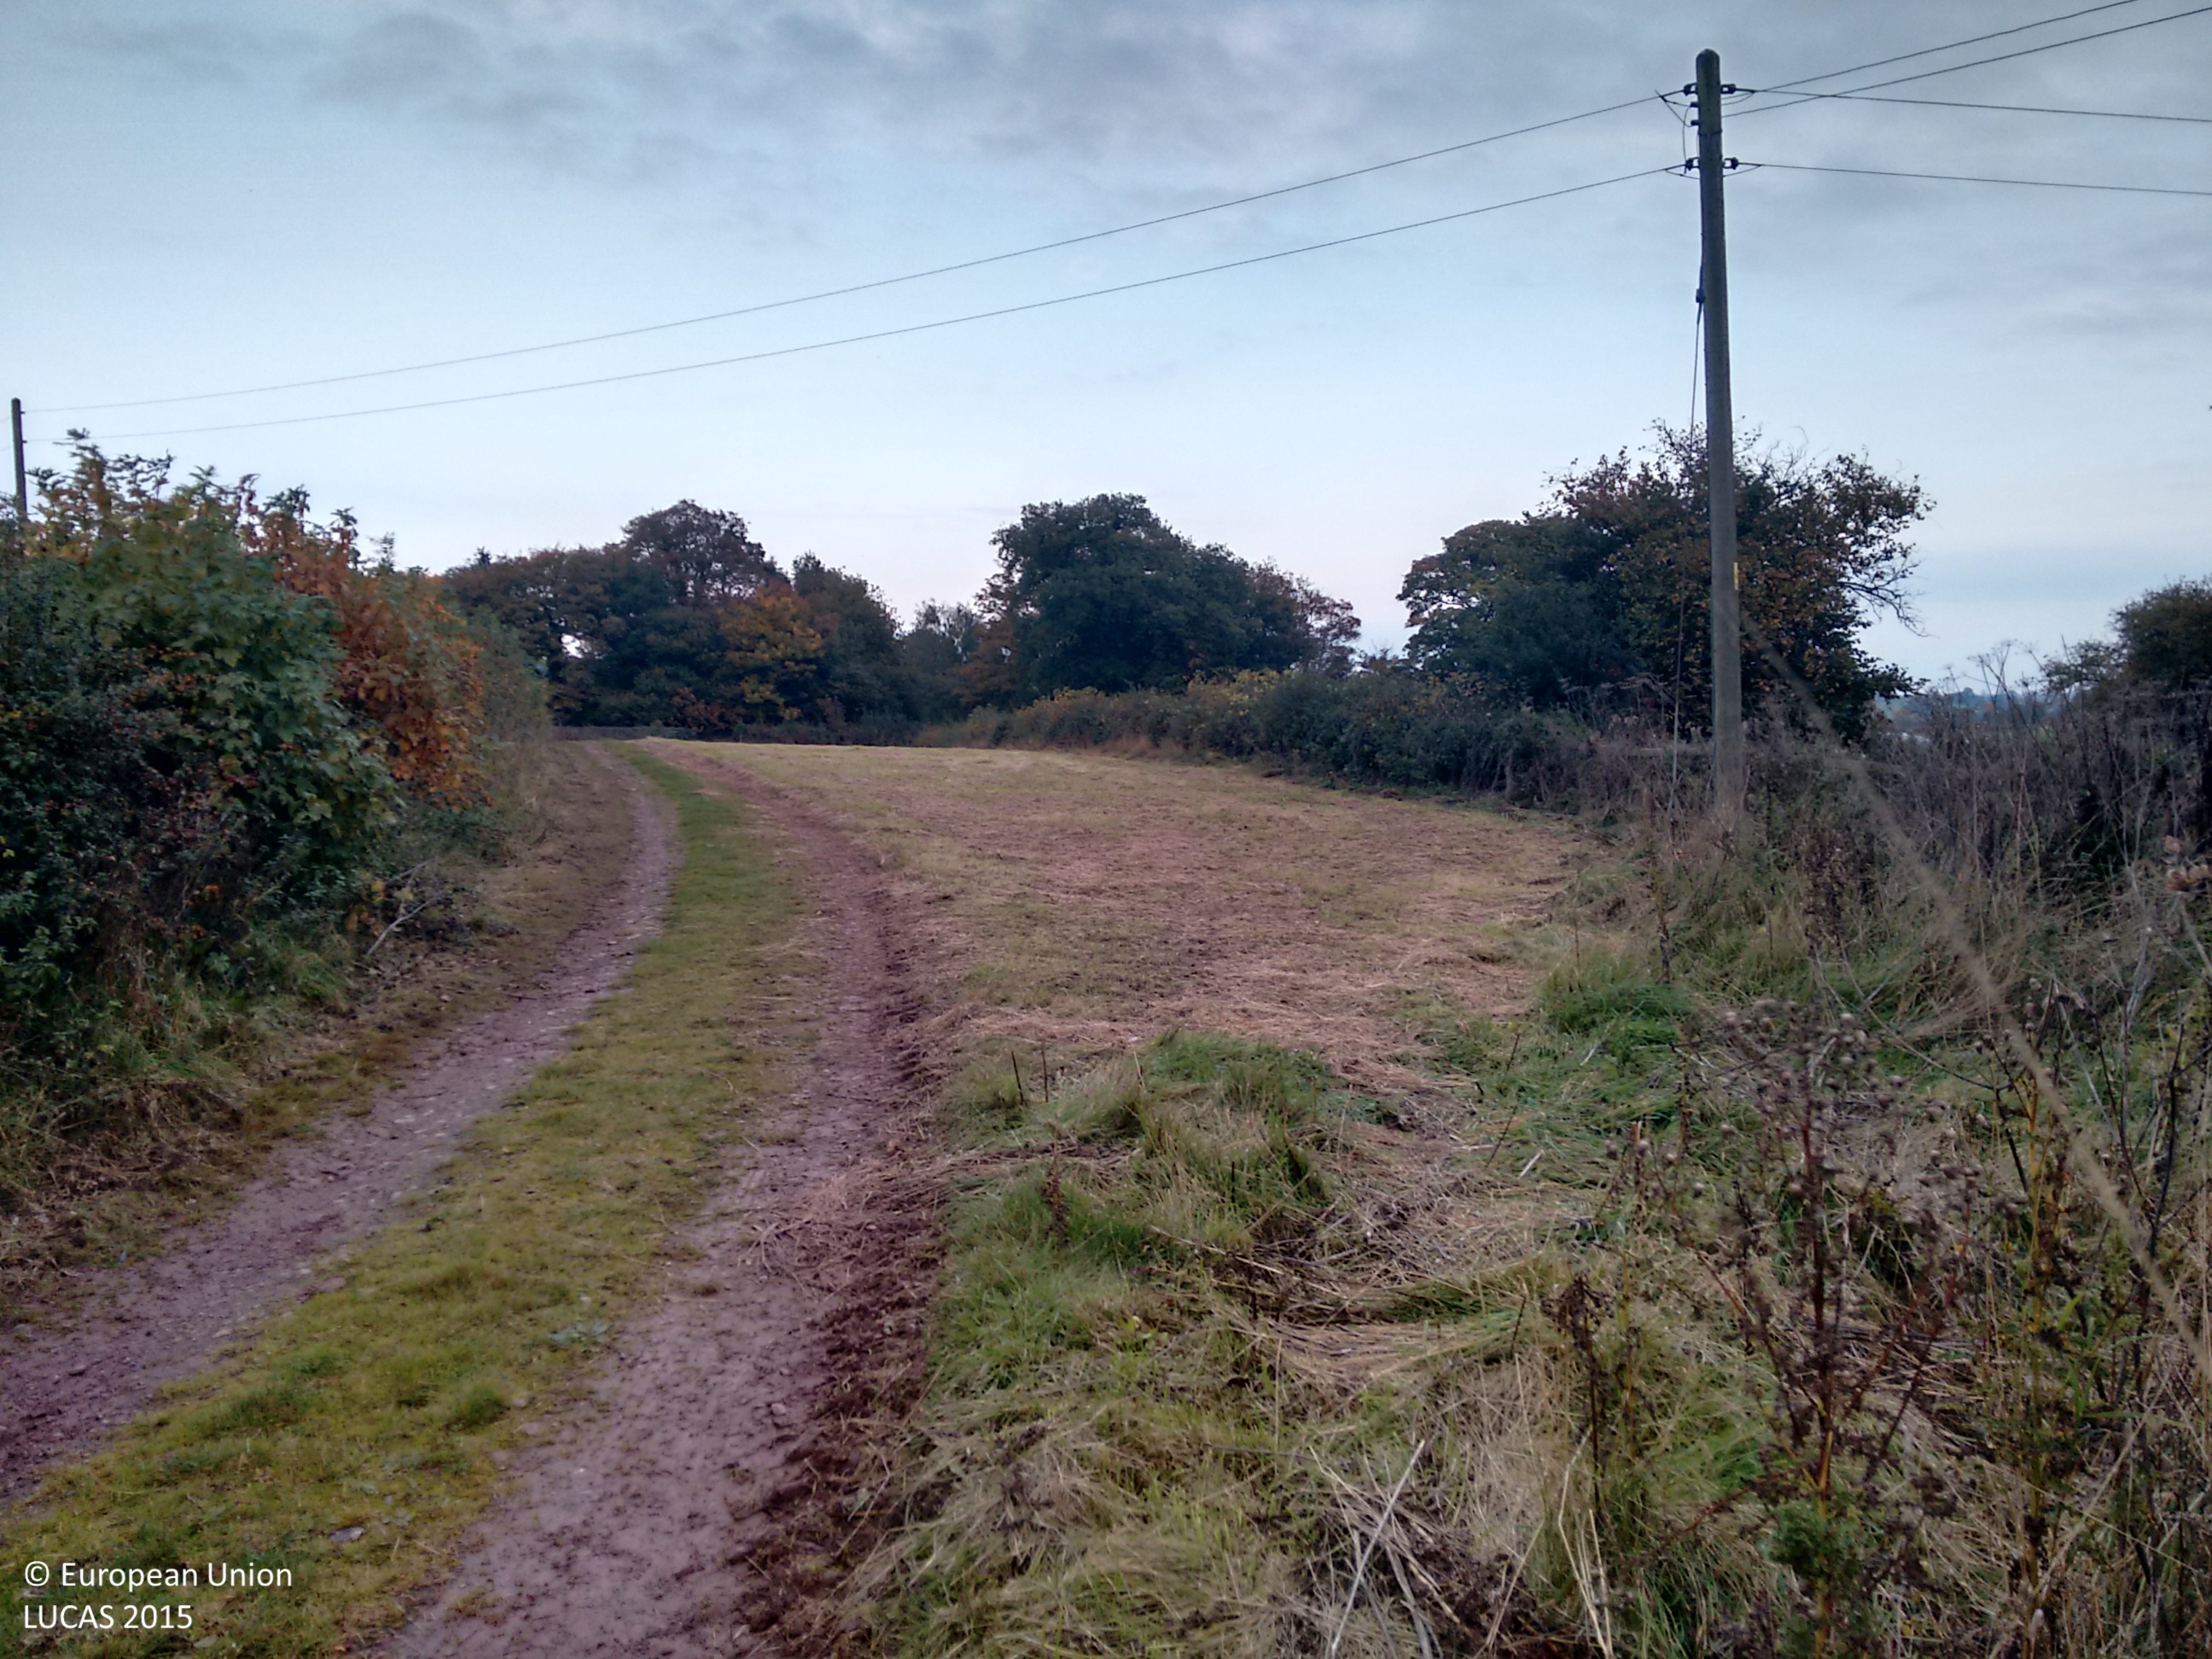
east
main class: Grassland
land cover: Grassland without tree/shrub cover
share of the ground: > 75 %
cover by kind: herbaceous plants 100 %
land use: Agriculture (excluding fallow land and kitchen gardens)
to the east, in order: Grassland without tree/shrub cover; Electric lines; Grassland without tree/shrub cover; Fences; Managed hedges; Fences; Grassland without tree/shrub cover; Fences; Managed hedges; Single bushes/trees; Grassland without tree/shrub cover; Paved roads, cycling and walking lanes; Grass margins; Fences; Single bushes/trees; Grassland without tree/shrub cover; Sand; Broadleaved woodland; Ditches and canals; Fences; Grassland without tree/shrub cover; Fences; Ditches and canals; Managed hedges
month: October
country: GB
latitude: 52.3962
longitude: -2.7534
